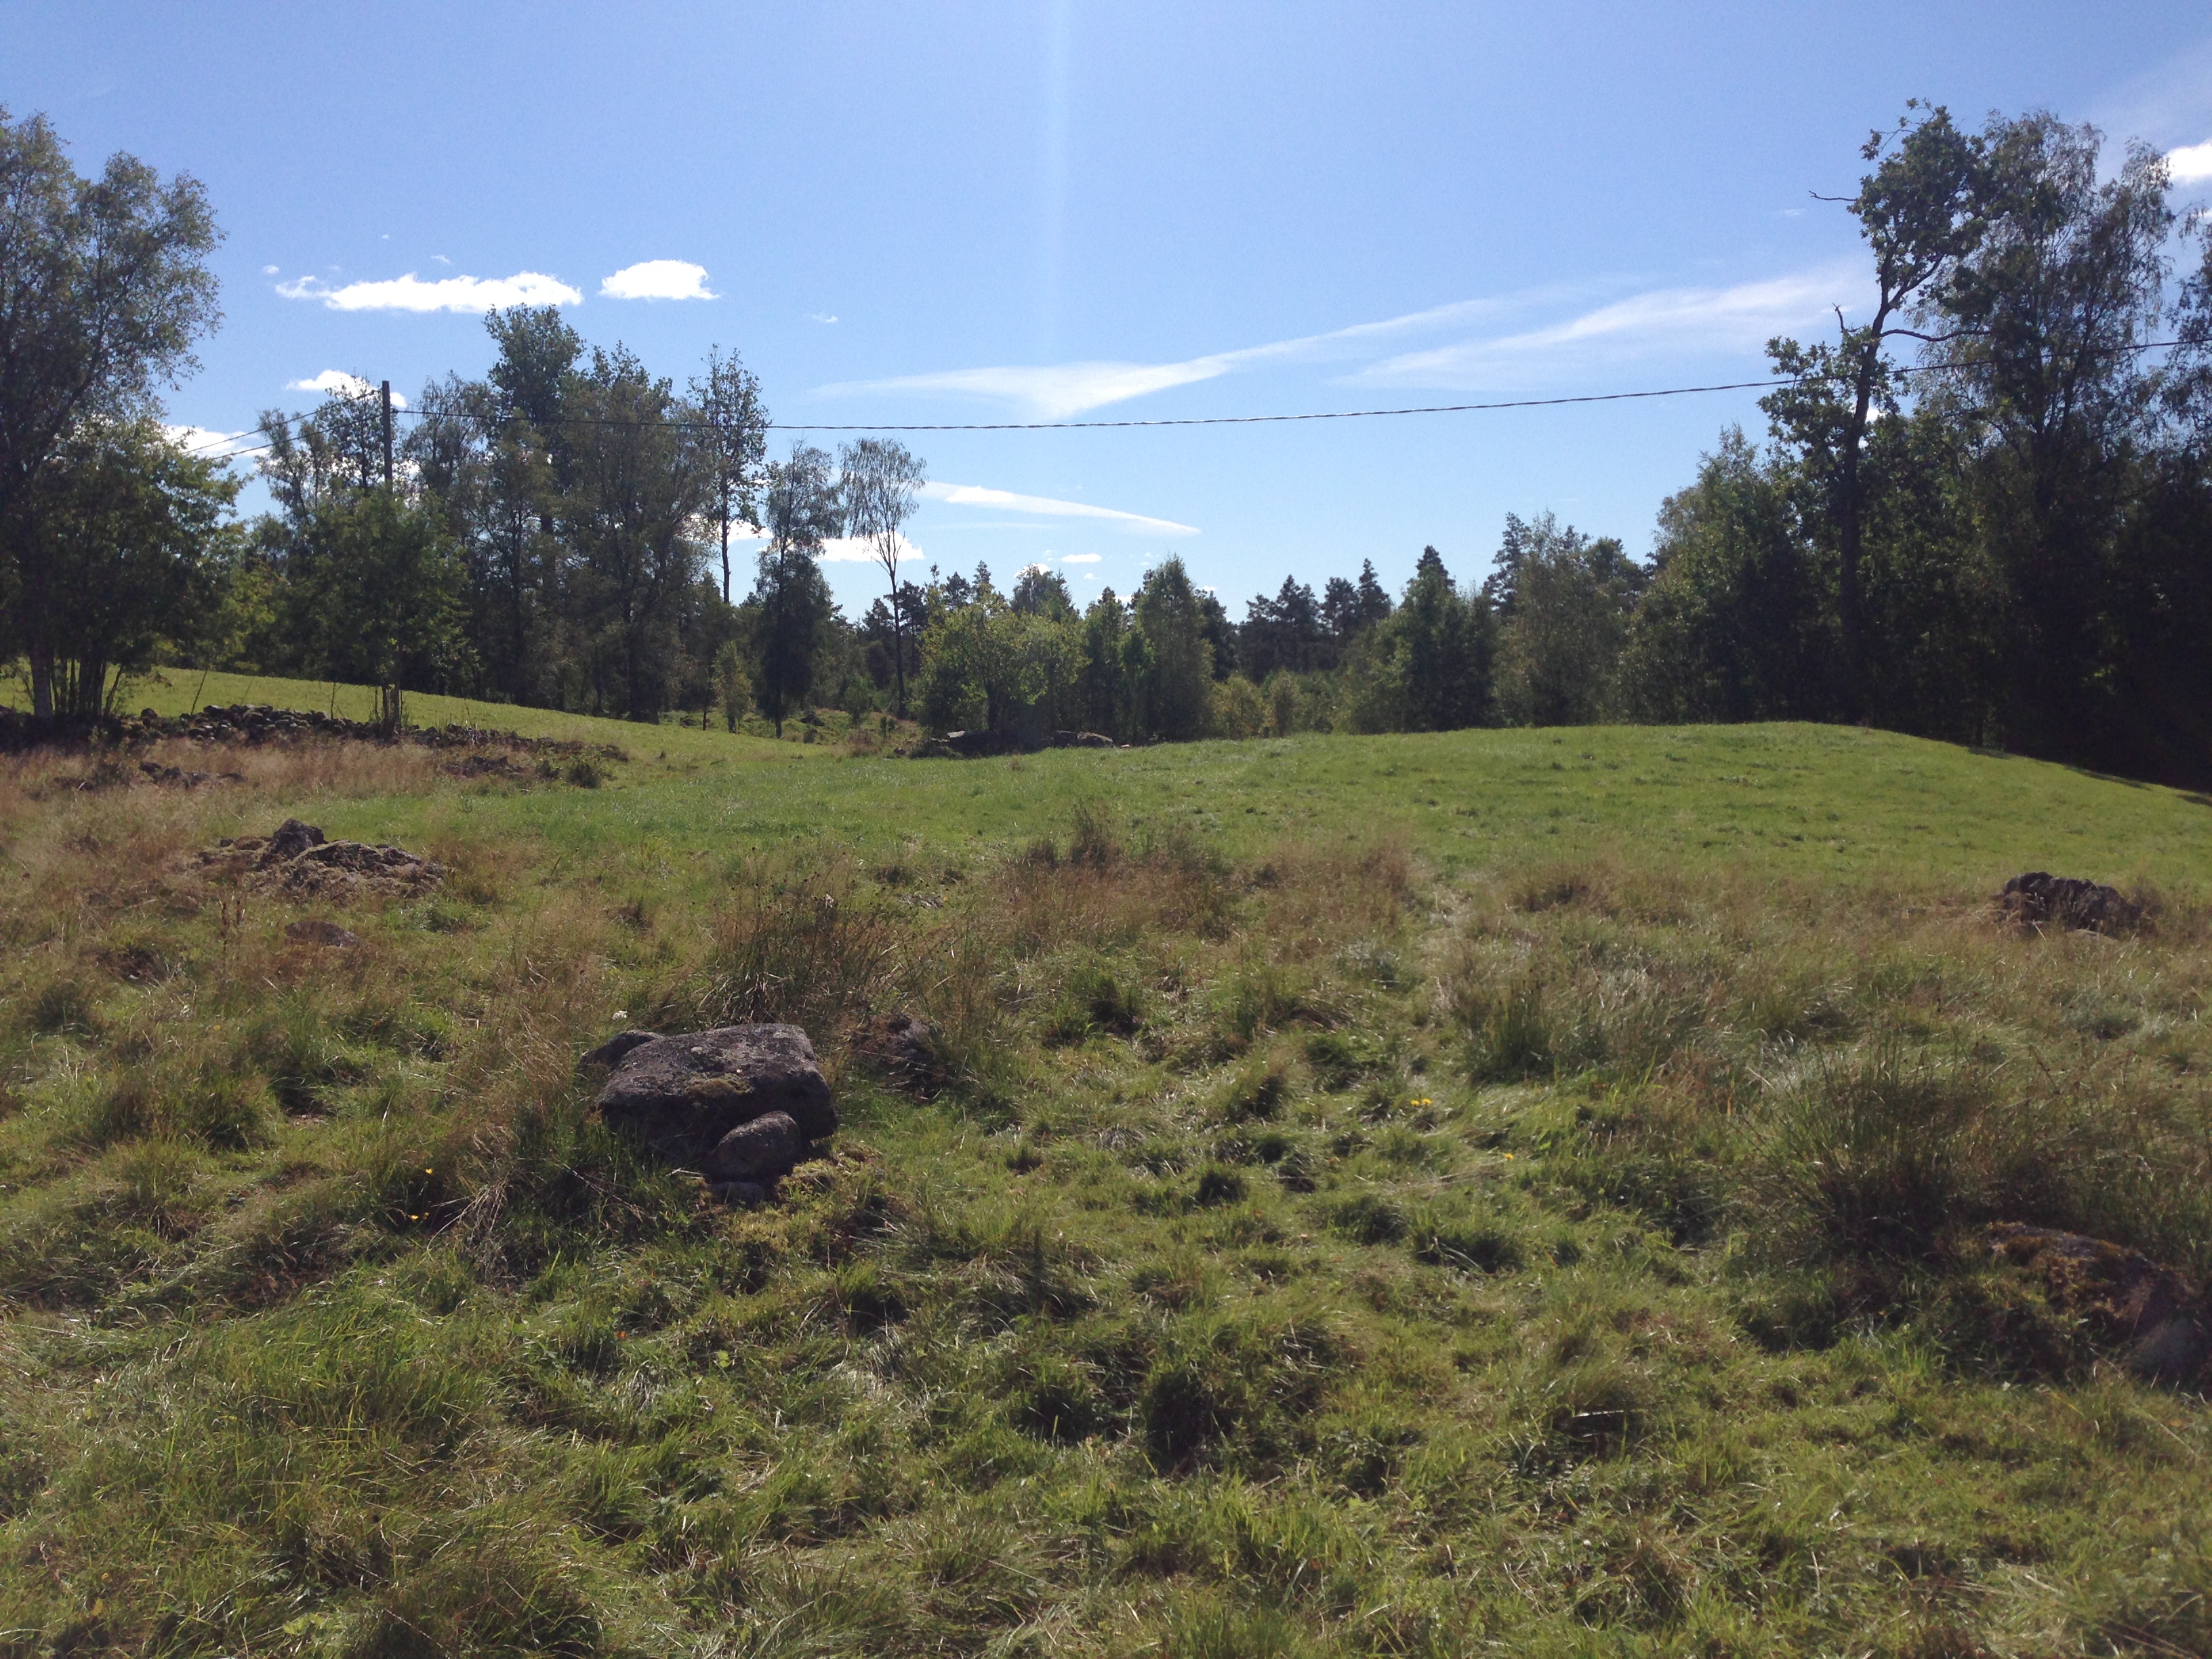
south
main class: Grassland
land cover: Grassland with sparse tree/shrub cover
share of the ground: > 75 %
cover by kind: herbaceous plants 90 %, broadleaved forest trees 5 %, shrubs 5 %
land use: Agriculture (excluding fallow land and kitchen gardens)
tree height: > 5 m
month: September
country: SE
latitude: 57.1551
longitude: 13.2198
